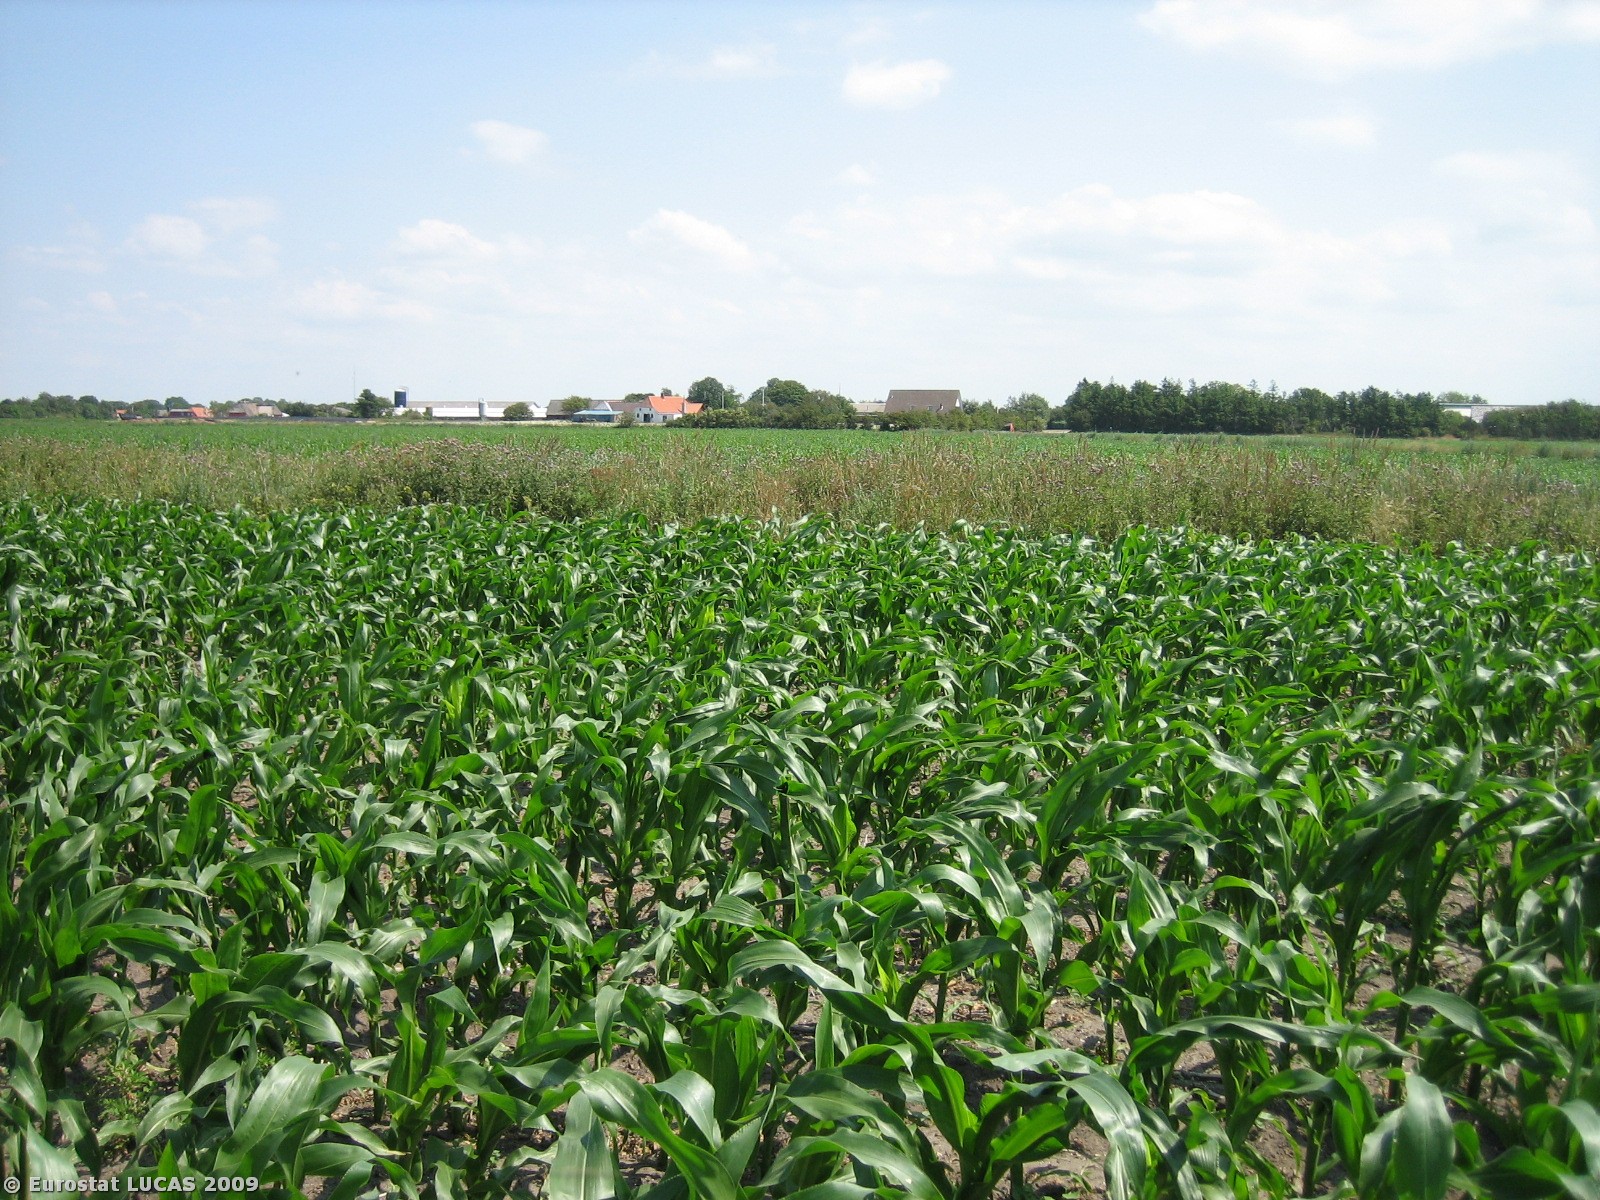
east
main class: Cropland
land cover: Maize
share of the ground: 50 - 75 %
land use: Agriculture (excluding fallow land and kitchen gardens)
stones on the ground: < 10 %
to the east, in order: Maize; Grassland without tree/shrub cover; Ditches and canals; Grass margins; Maize; Grass margins; Tracks
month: July
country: DK
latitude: 55.3545
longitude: 8.7235
